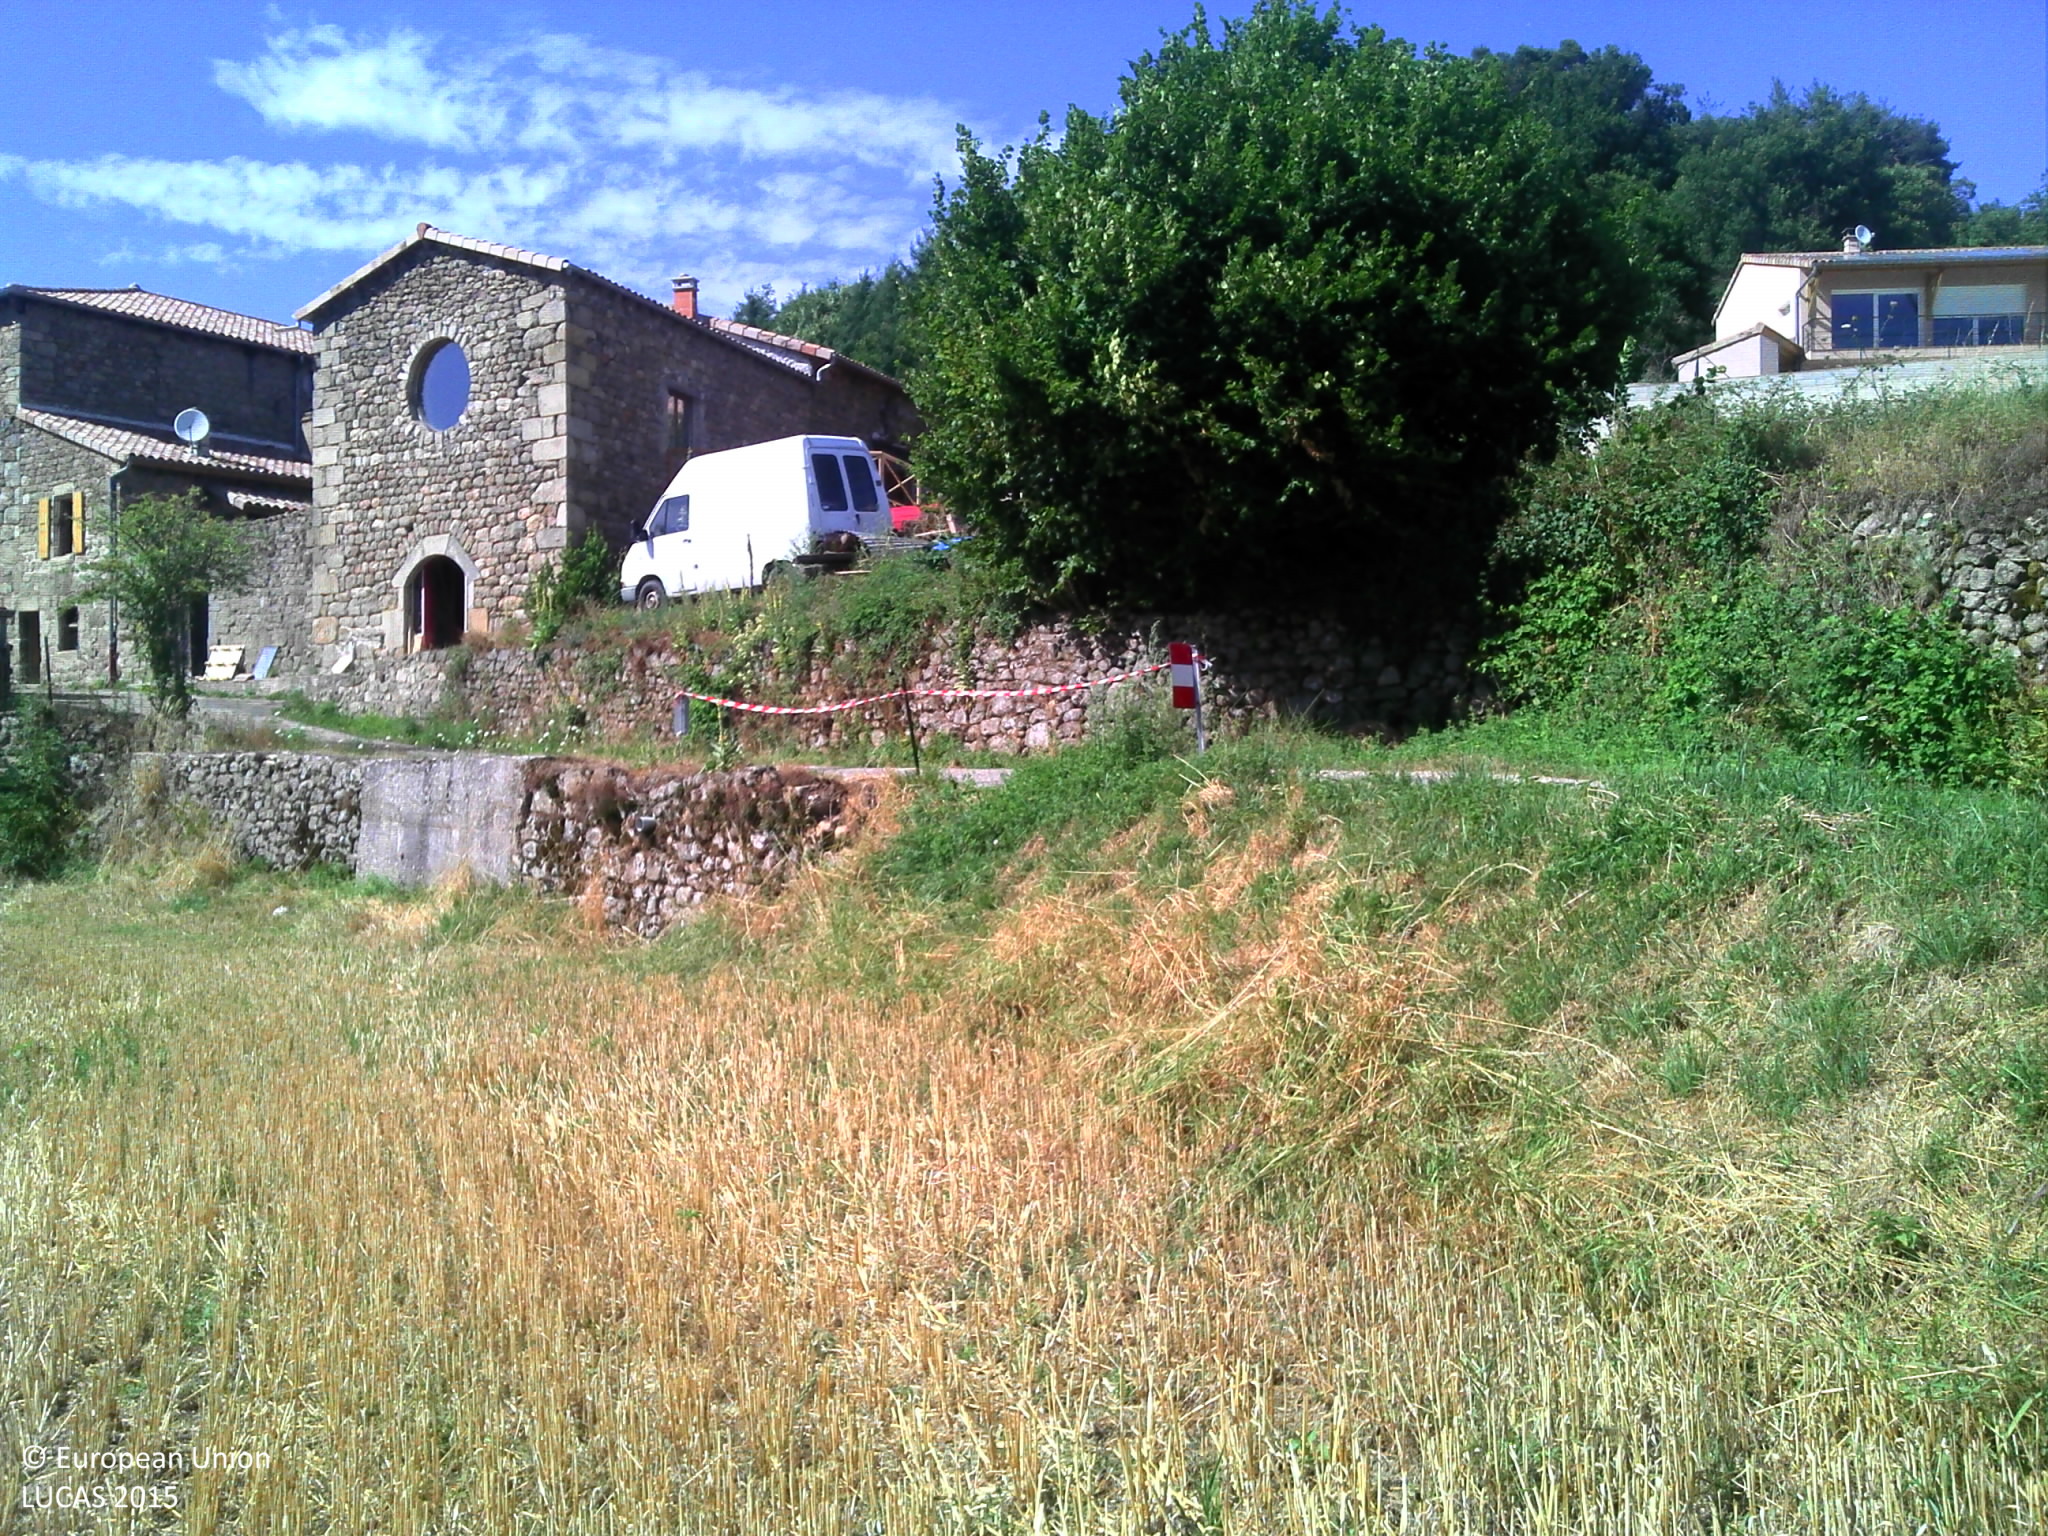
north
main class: Cropland
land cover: Barley
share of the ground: > 75 %
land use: Agriculture (excluding fallow land and kitchen gardens)
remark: Harvested field
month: July
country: FR
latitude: 44.9145
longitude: 4.5967
